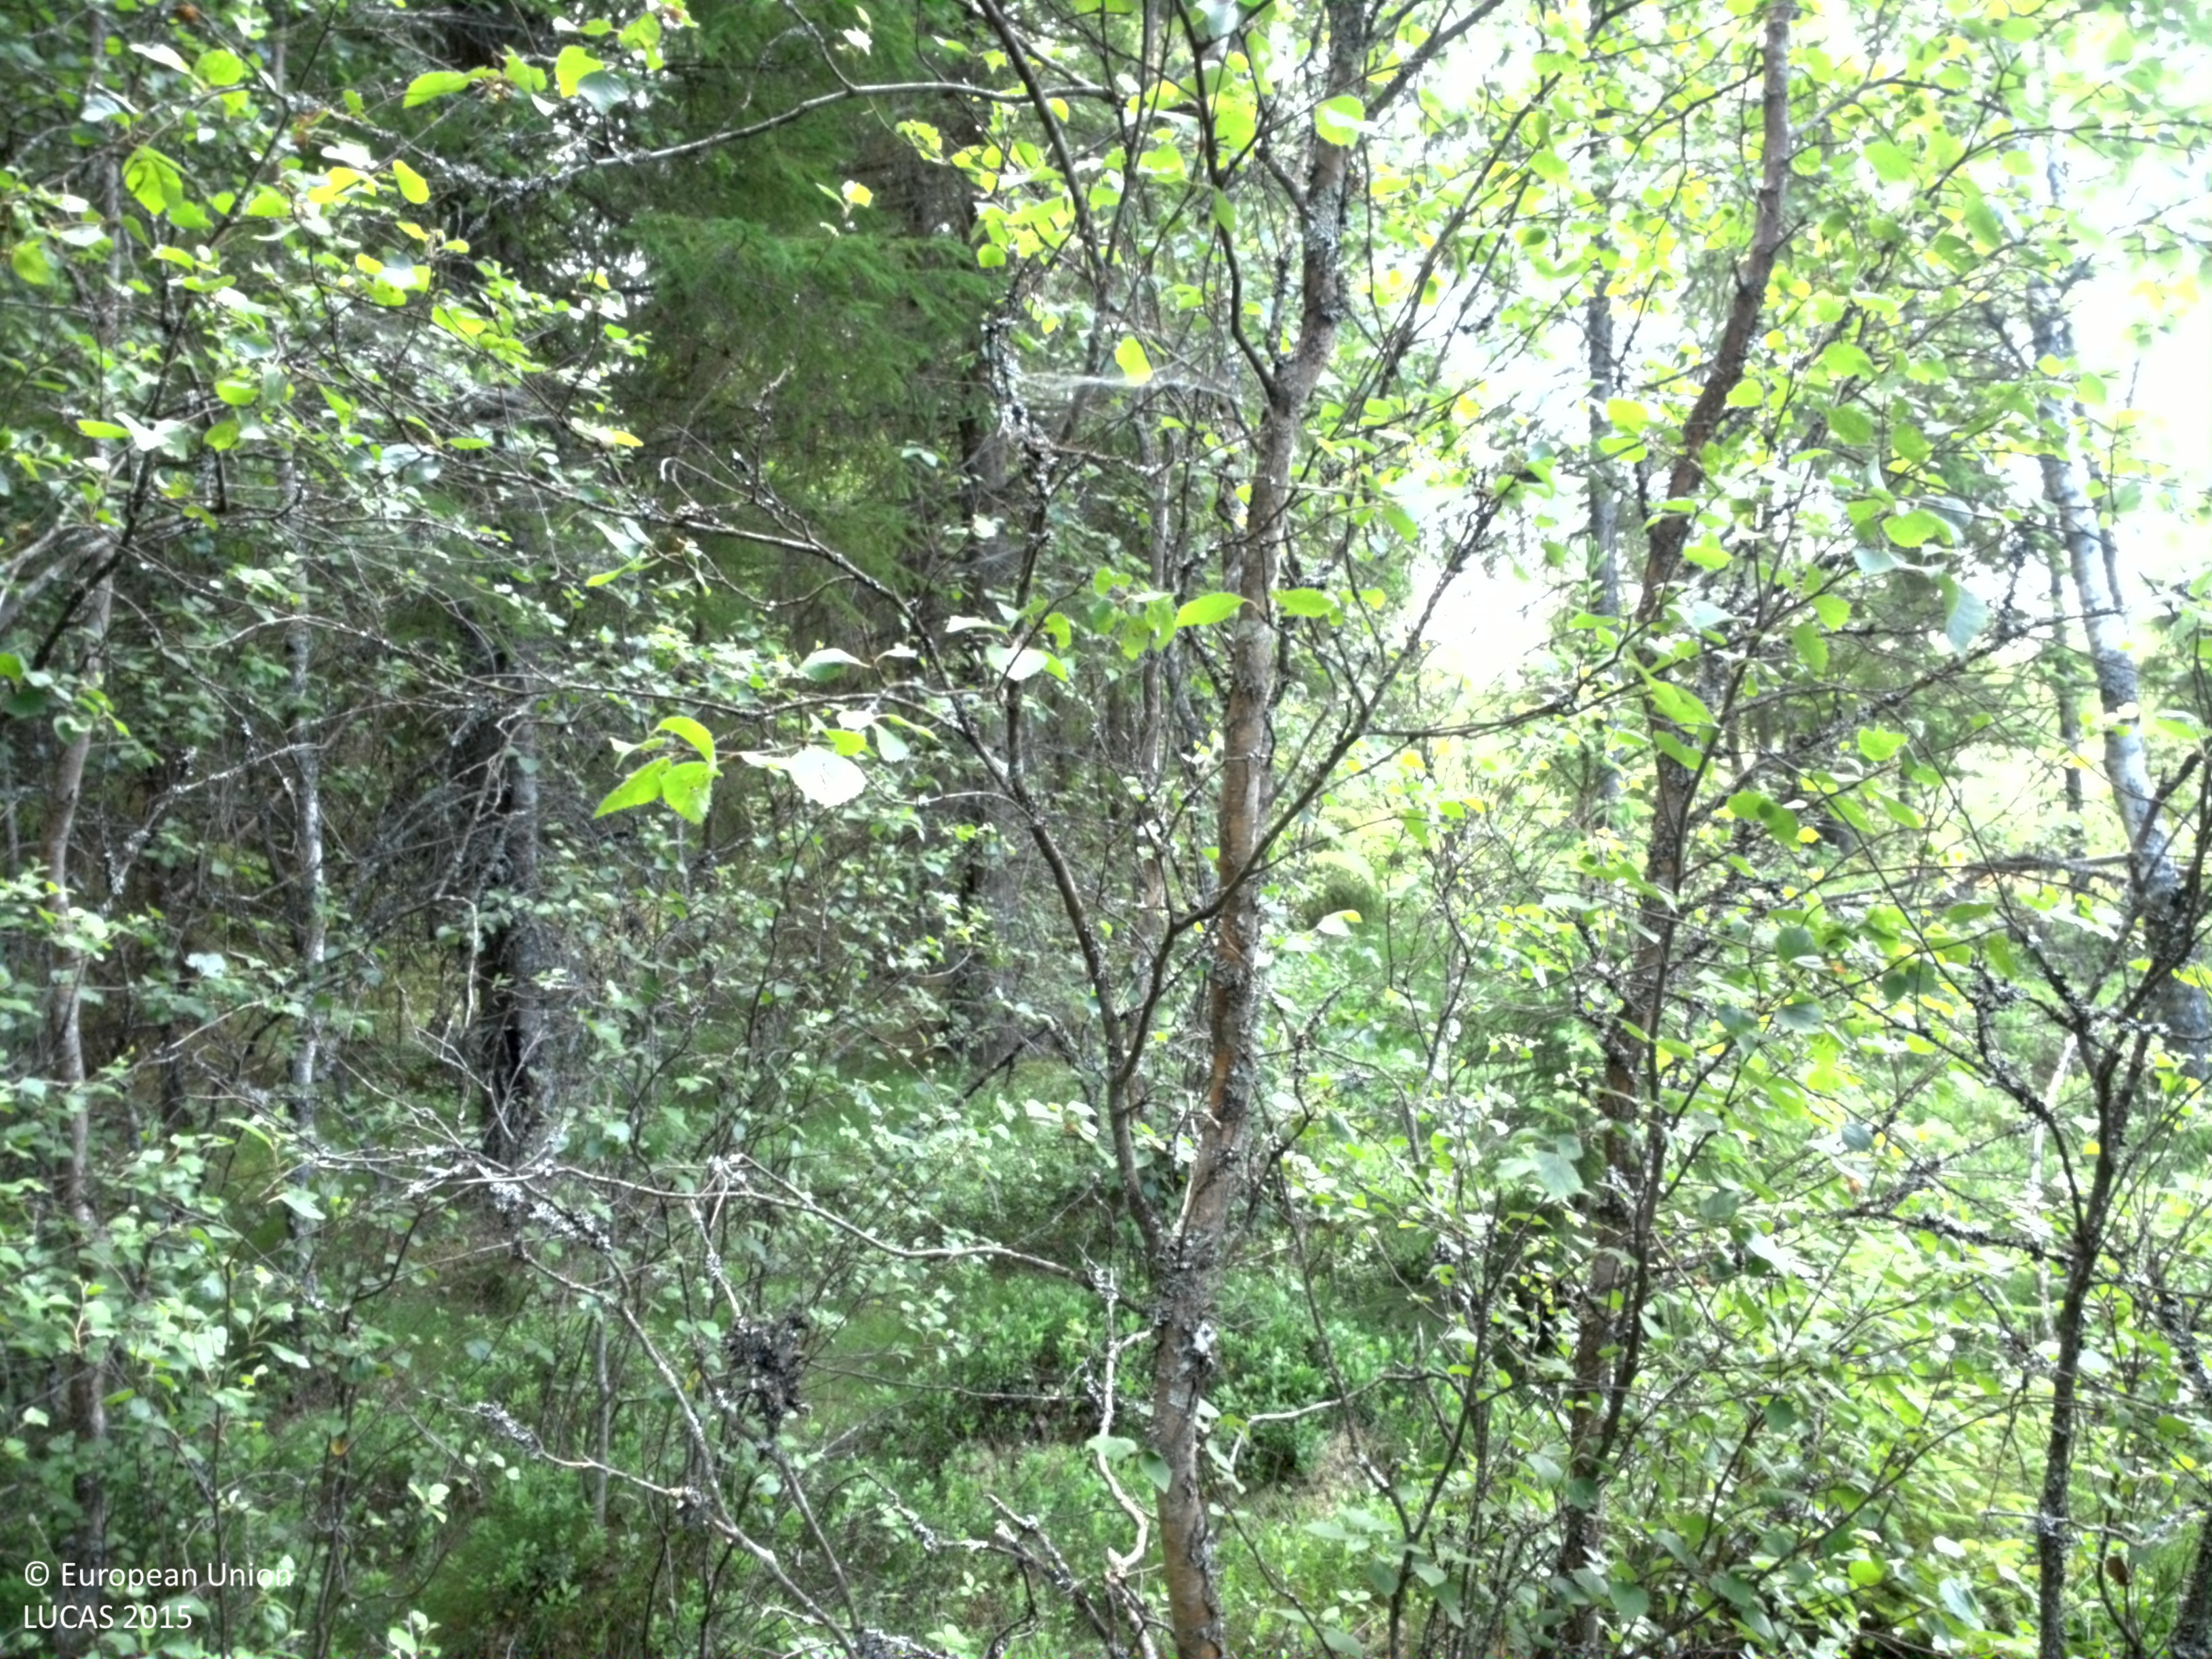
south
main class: Woodland
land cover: Spruce dominated mixed woodland
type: boreal forest
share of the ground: 50 - 75 %
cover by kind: coniferous forest trees 40 %, broadleaved forest trees 35 %, shrubs 20 %, herbaceous plants 5 %
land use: Forestry
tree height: > 5 m
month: July
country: SE
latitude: 57.6597
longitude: 13.8669
